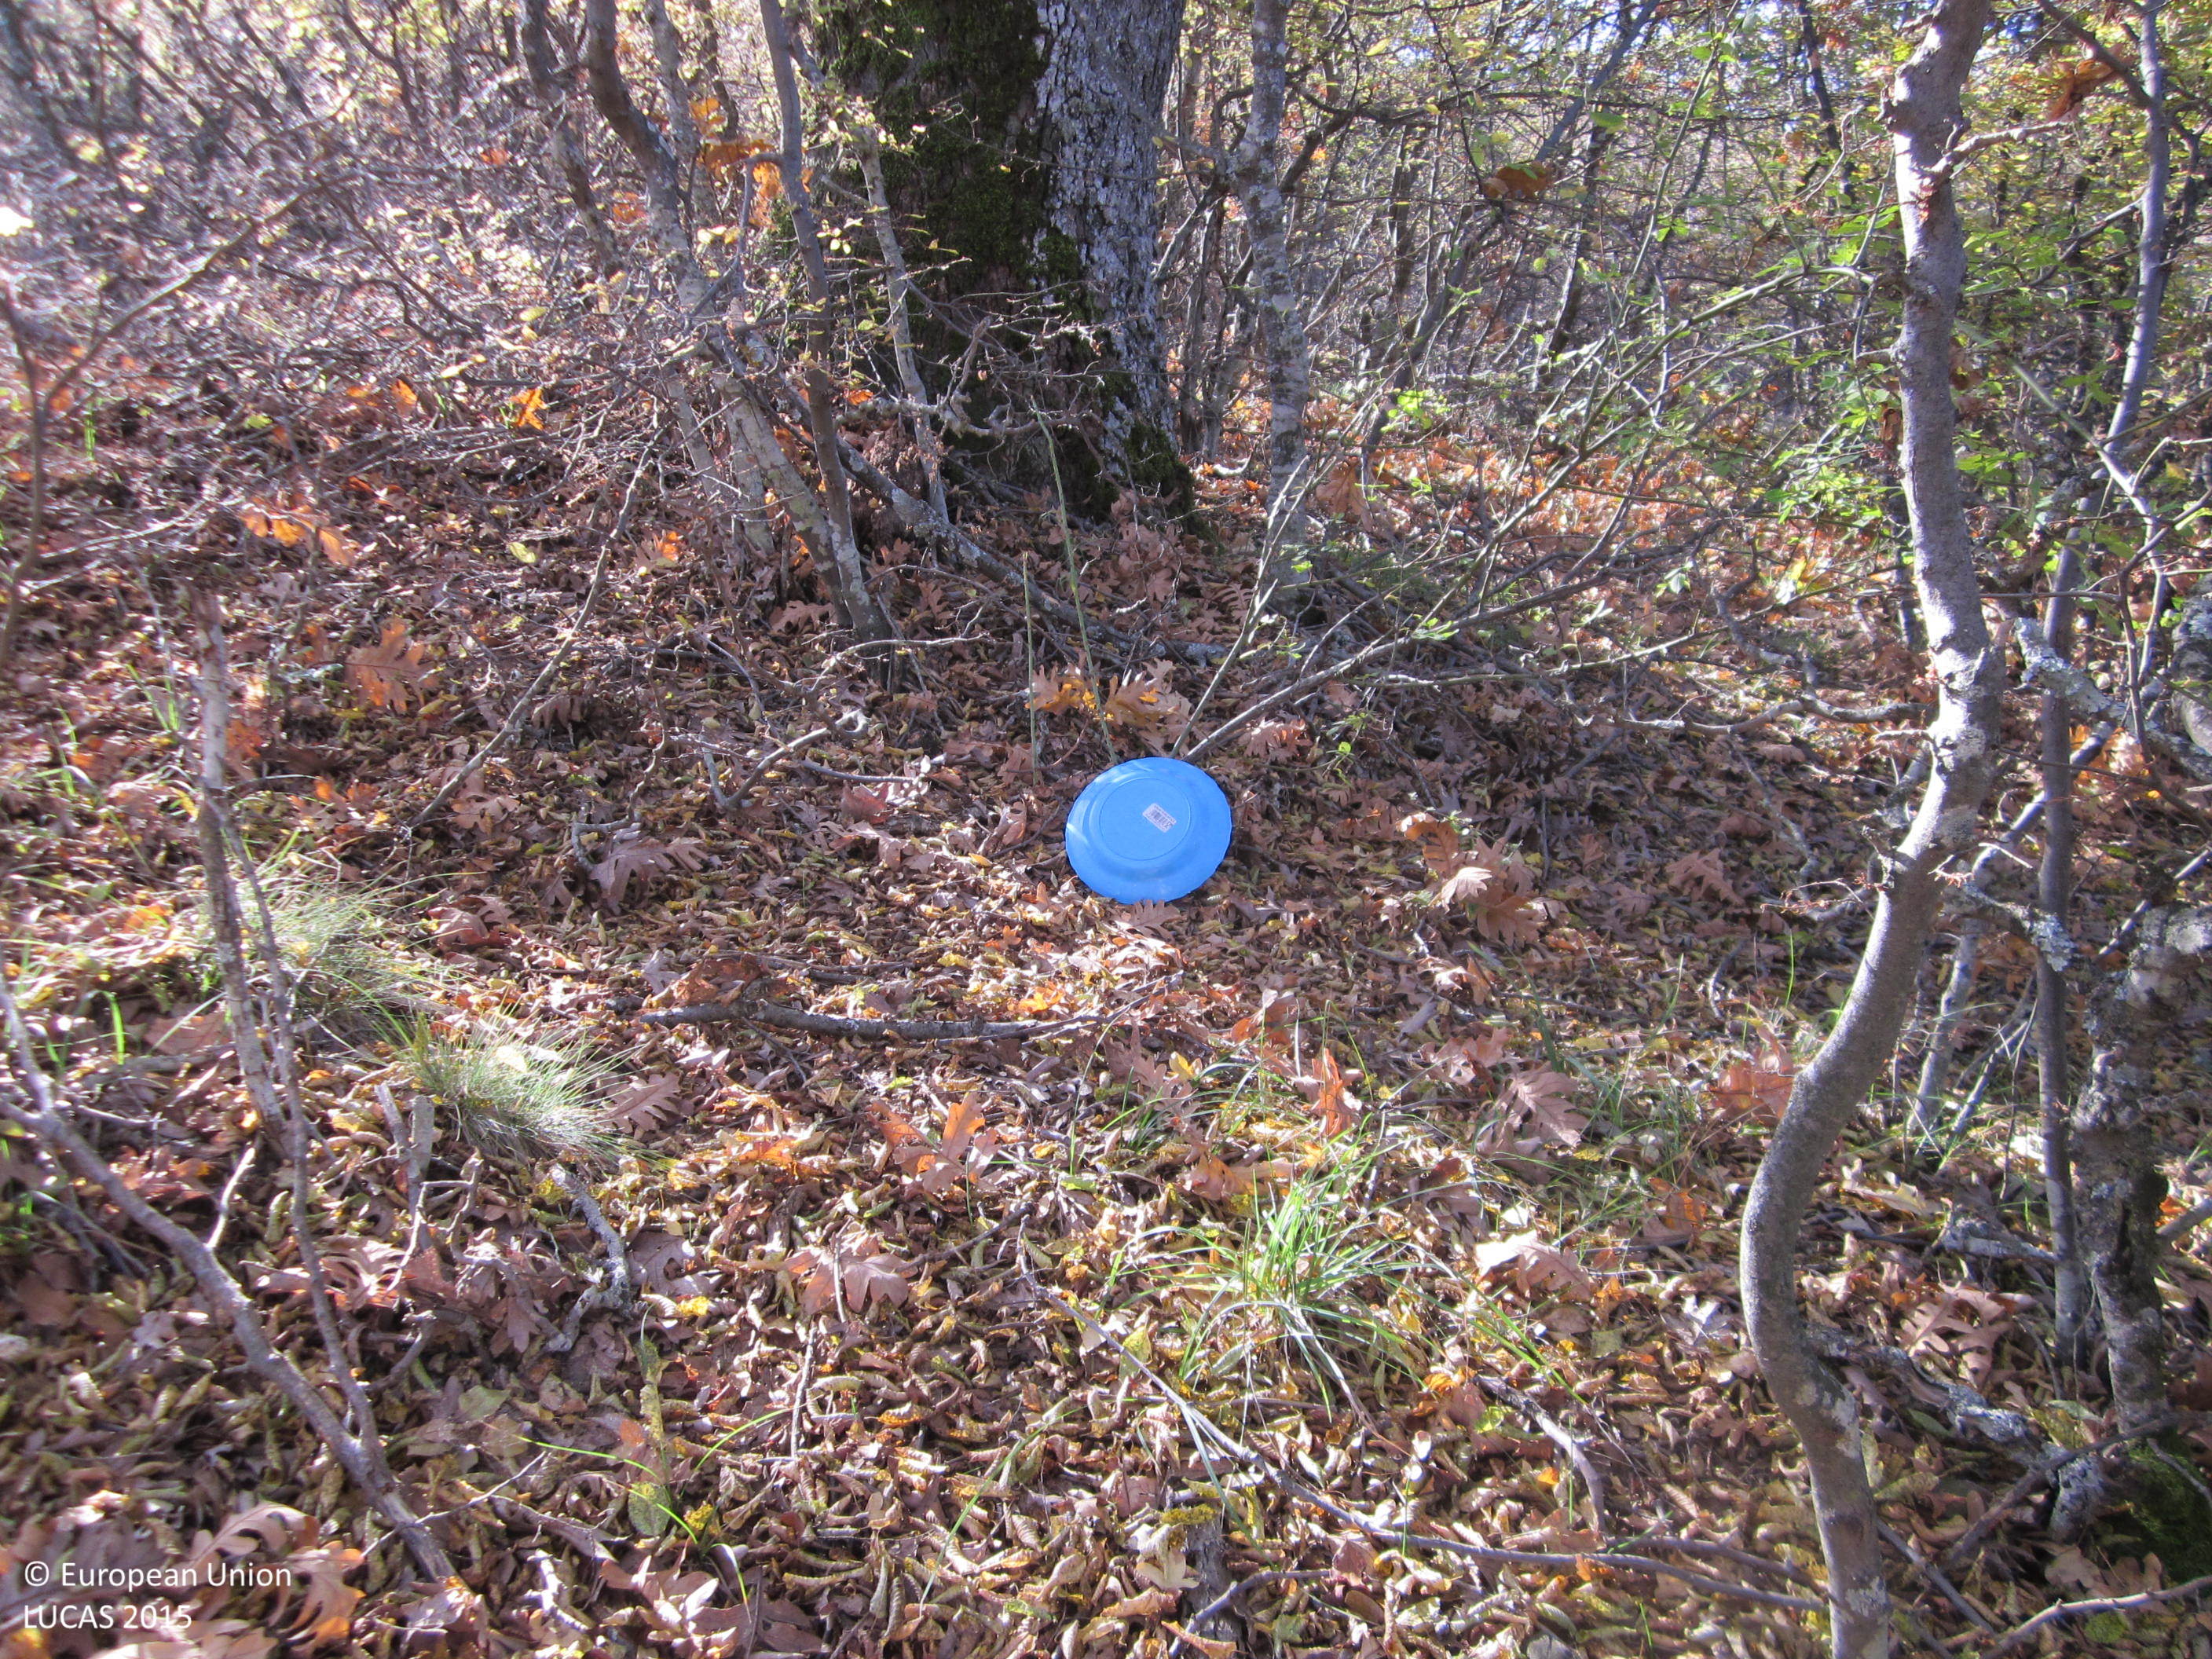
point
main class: Woodland
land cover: Broadleaved woodland
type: mesophytic deciduous forest
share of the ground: > 75 %
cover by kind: broadleaved forest trees 80 %, herbaceous plants 15 %, shrubs 5 %
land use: Forestry
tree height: > 5 m
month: November
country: BG
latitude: 41.4878
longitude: 25.7404
